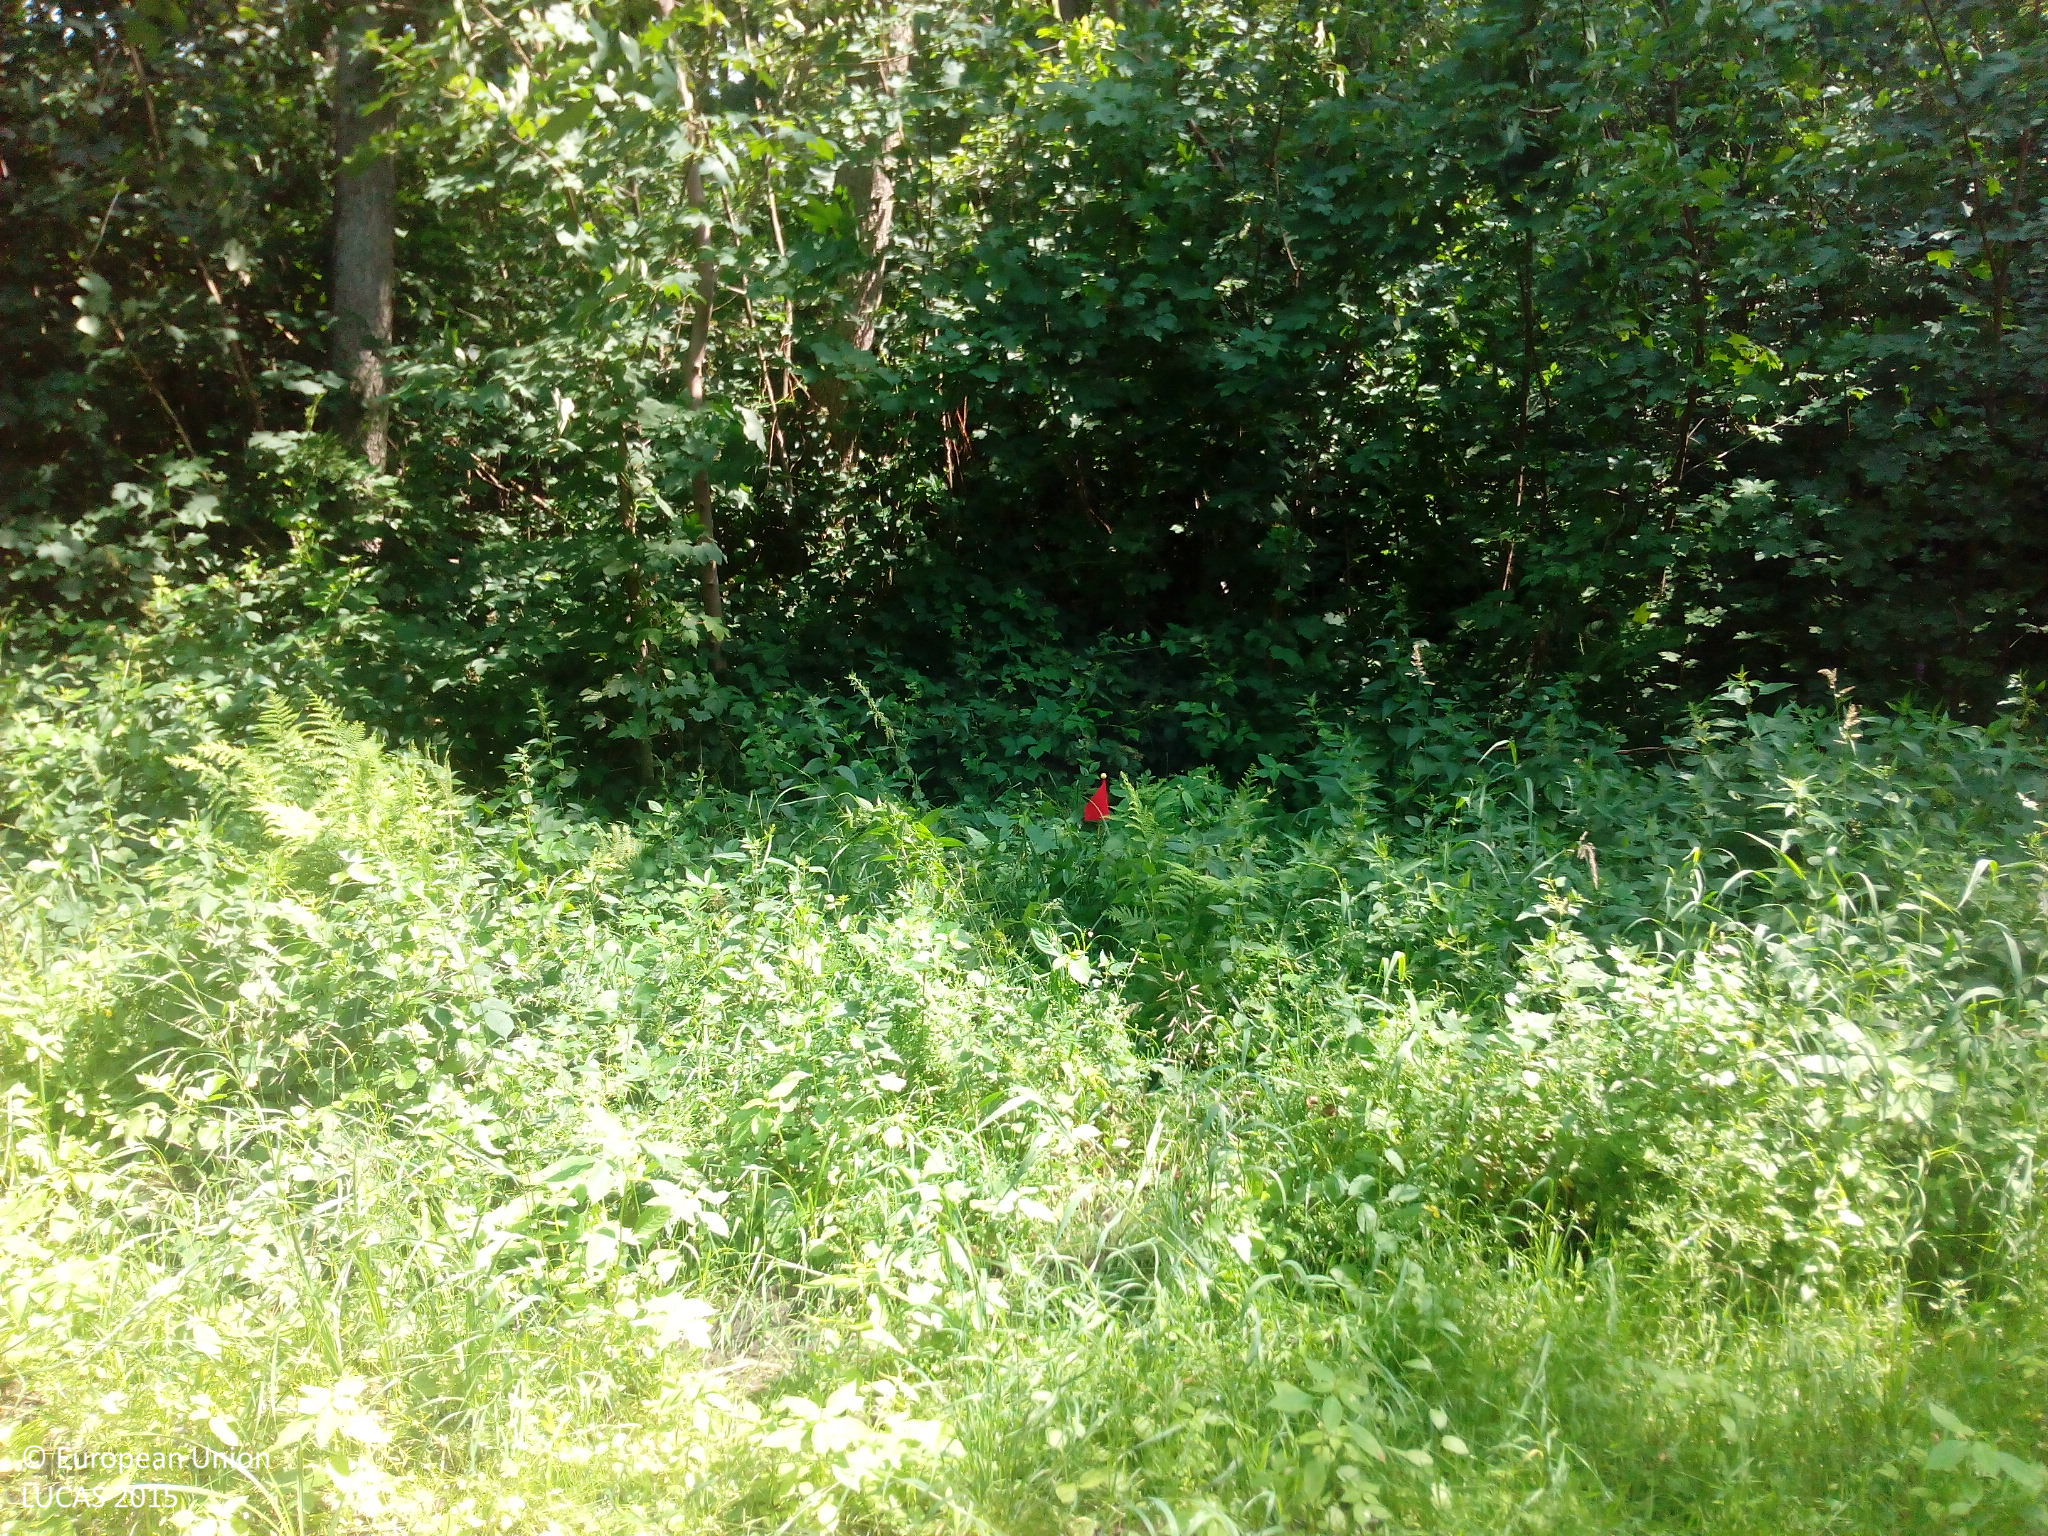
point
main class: Woodland
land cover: Broadleaved woodland
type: mesophytic deciduous forest
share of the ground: > 75 %
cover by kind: broadleaved forest trees 95 %, herbaceous plants 5 %
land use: Forestry
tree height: > 5 m
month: July
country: DE
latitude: 52.8384
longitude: 12.4192
